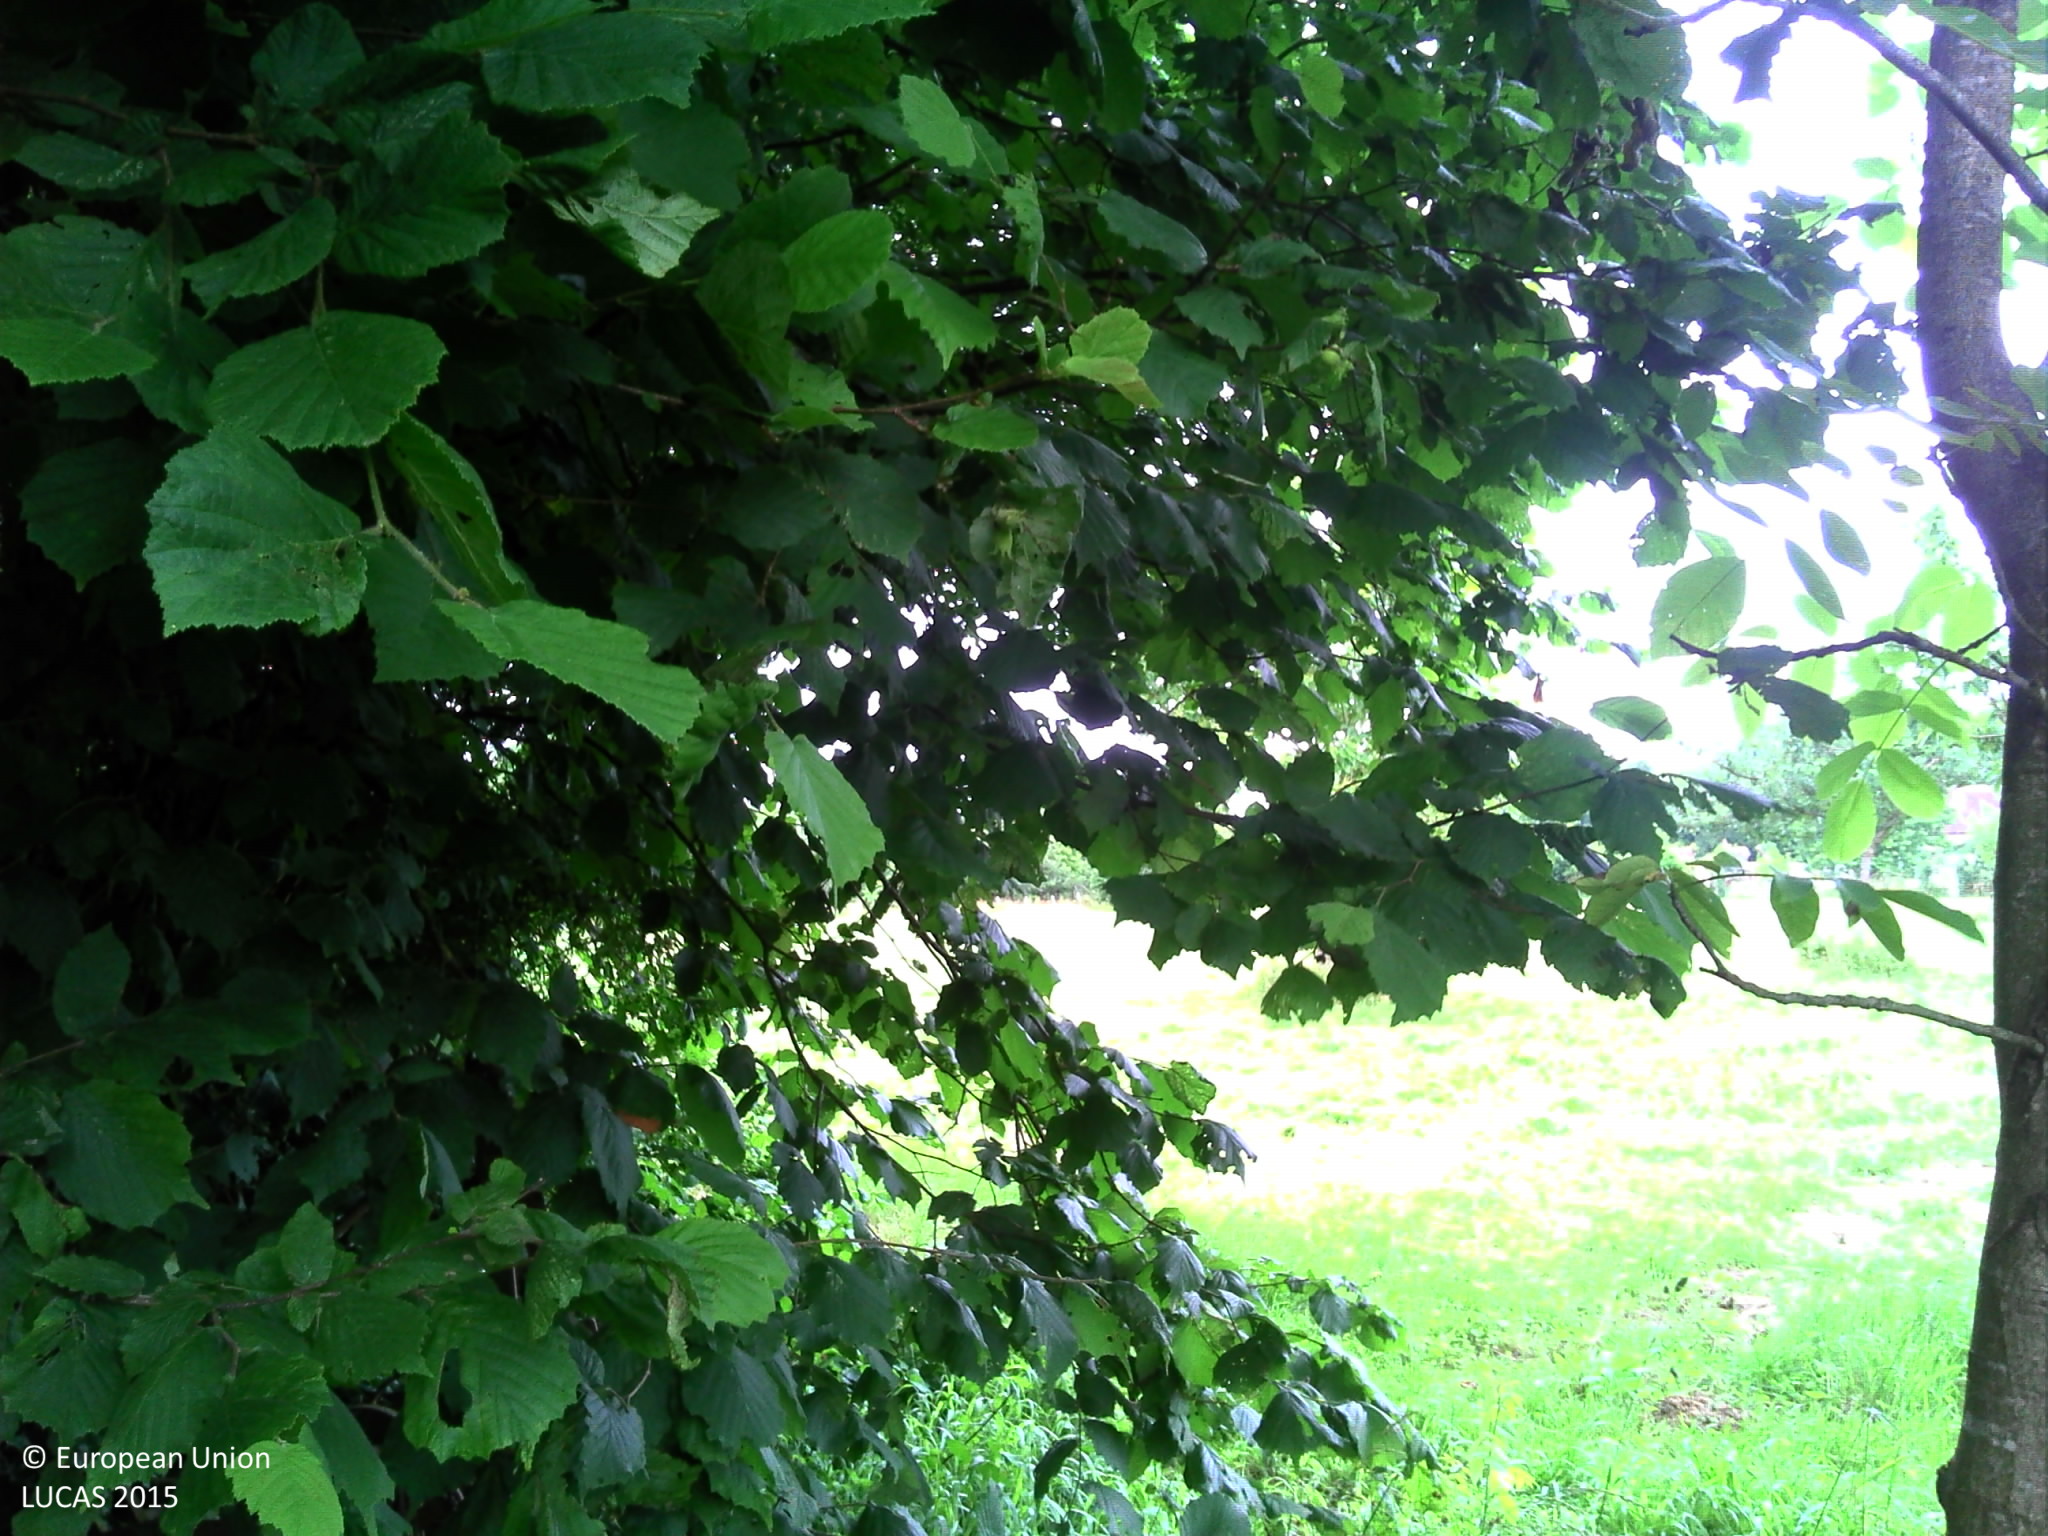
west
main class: Grassland
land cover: Grassland with sparse tree/shrub cover
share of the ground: > 75 %
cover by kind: herbaceous plants 95 %, broadleaved forest trees 5 %
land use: Agriculture (excluding fallow land and kitchen gardens)
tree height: > 5 m
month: June
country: FR
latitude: 48.0417
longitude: 0.2225
